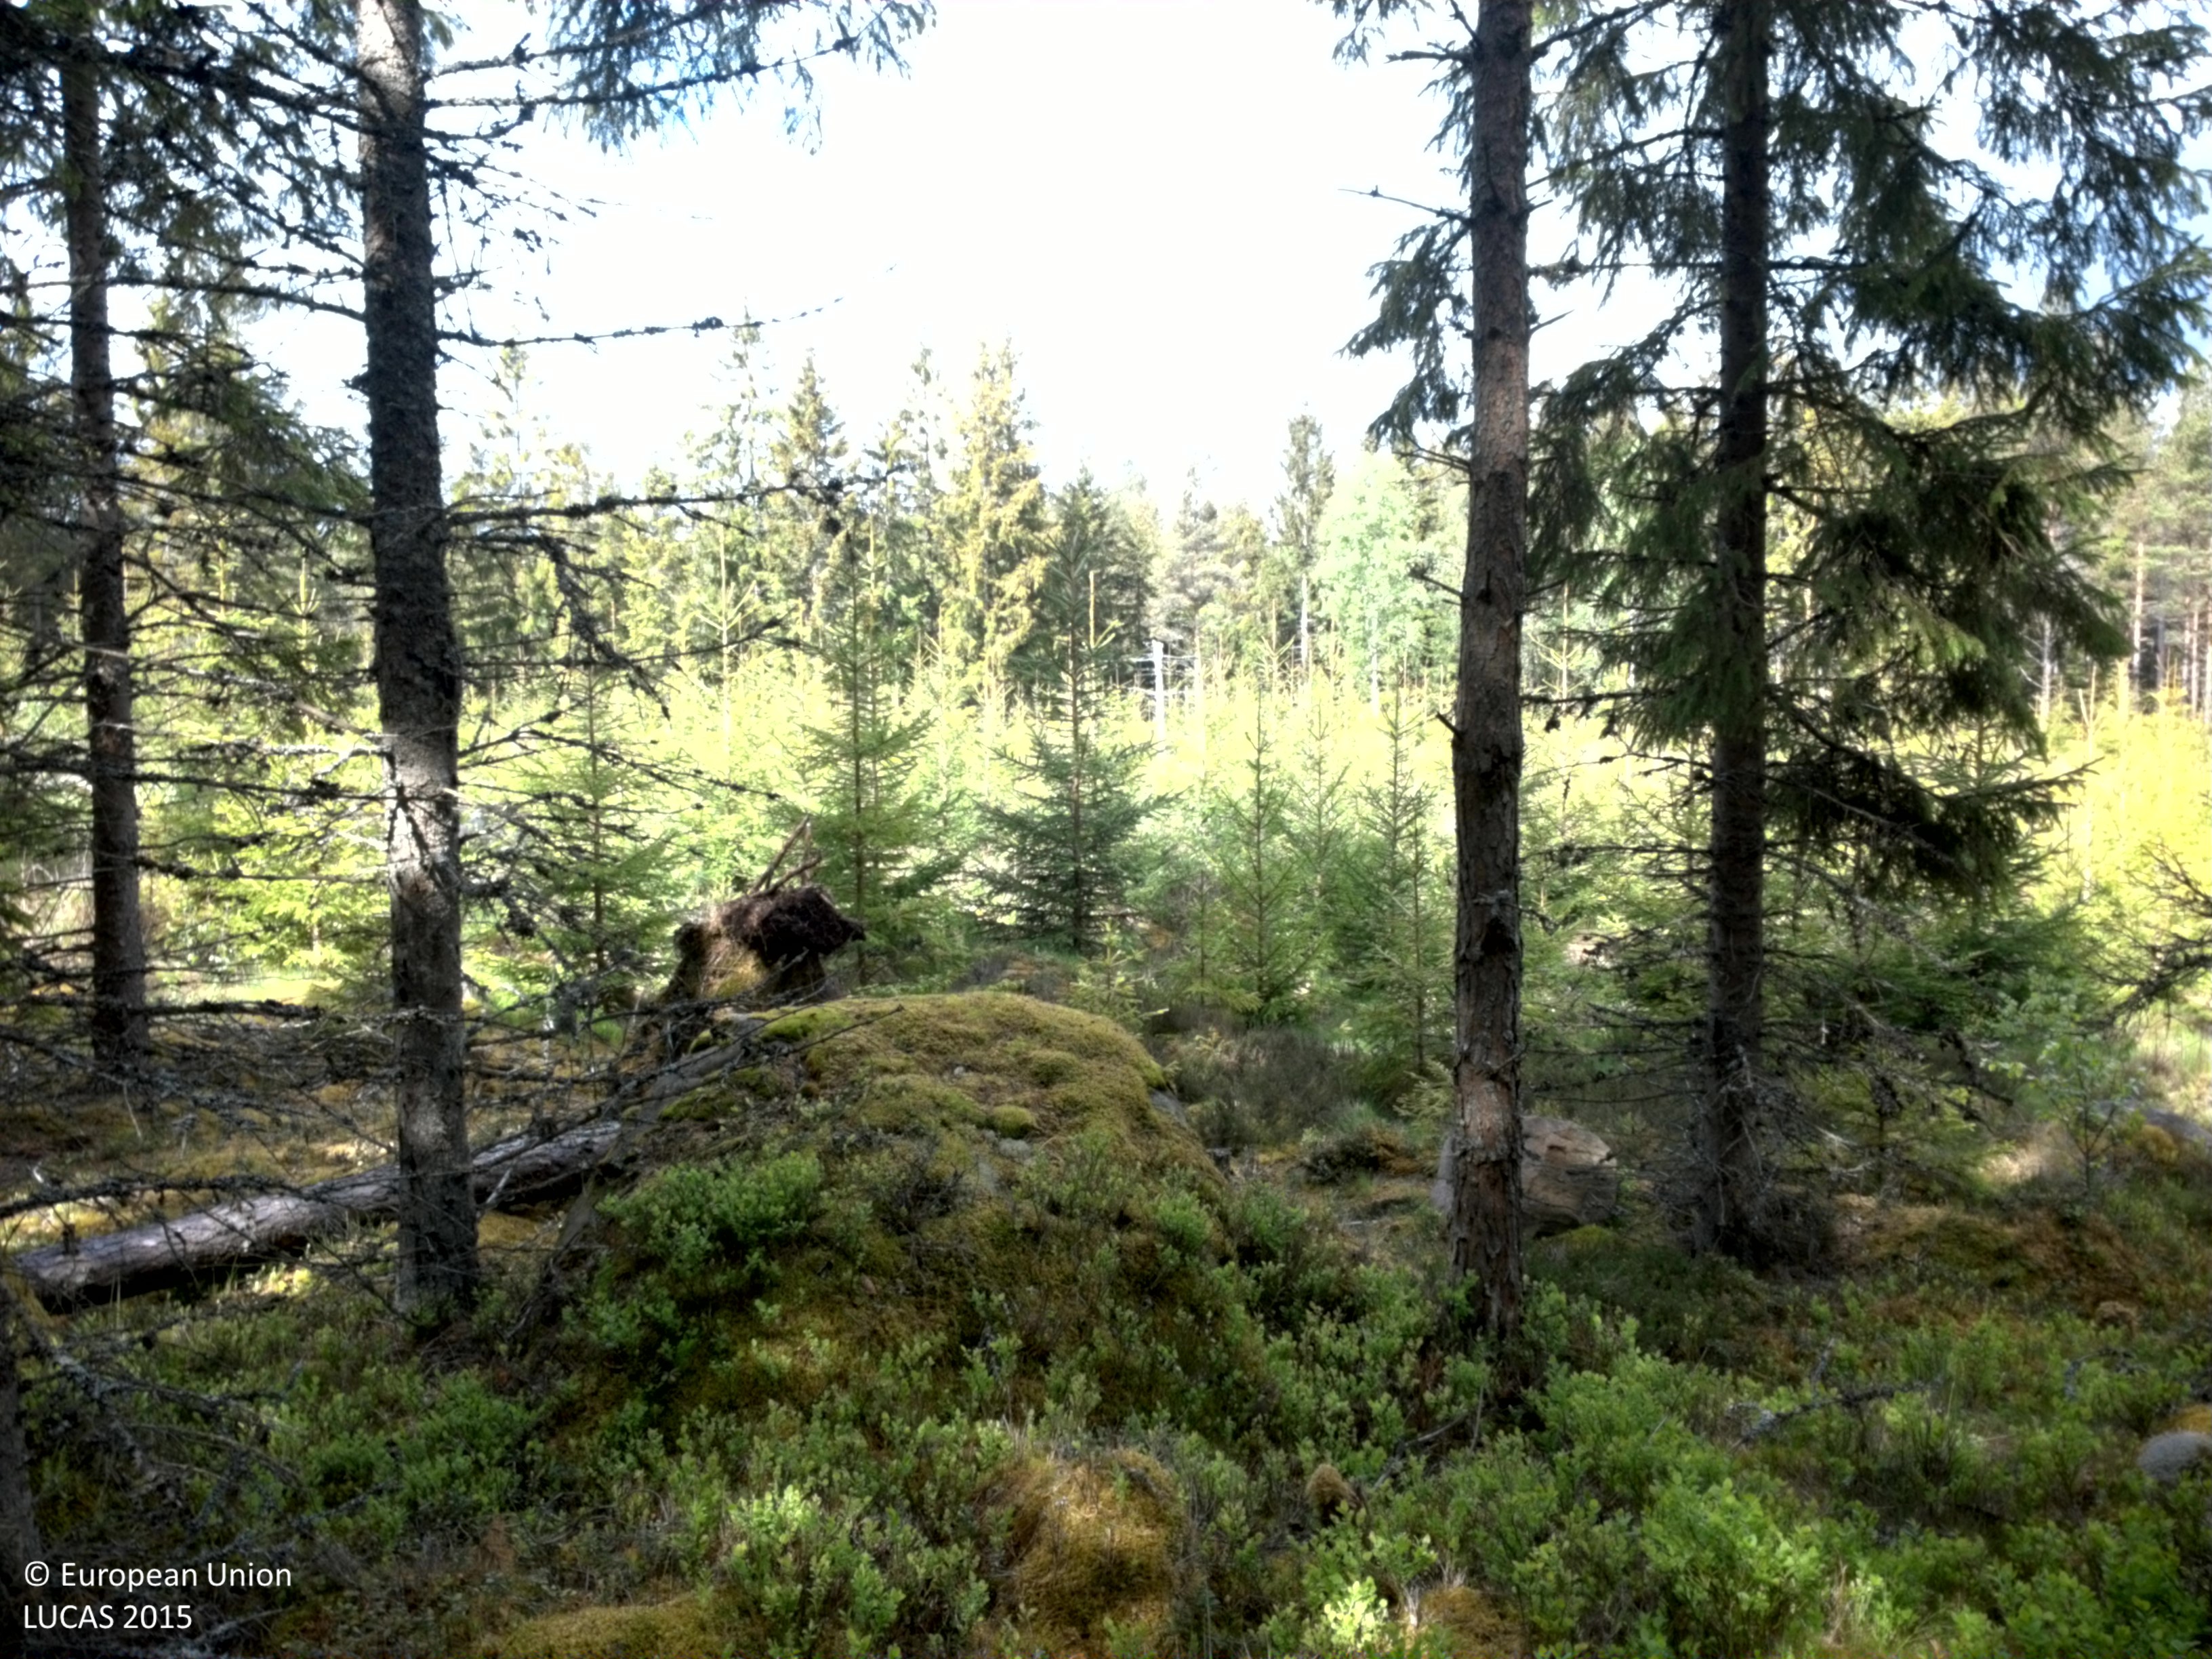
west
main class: Woodland
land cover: Spruce dominated coniferous woodland
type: boreal forest
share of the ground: 50 - 75 %
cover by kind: coniferous forest trees 50 %, shrubs 20 %, lichens and mosses 20 %, herbaceous plants 10 %
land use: Forestry
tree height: > 5 m
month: June
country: SE
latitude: 56.7809
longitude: 14.3340
